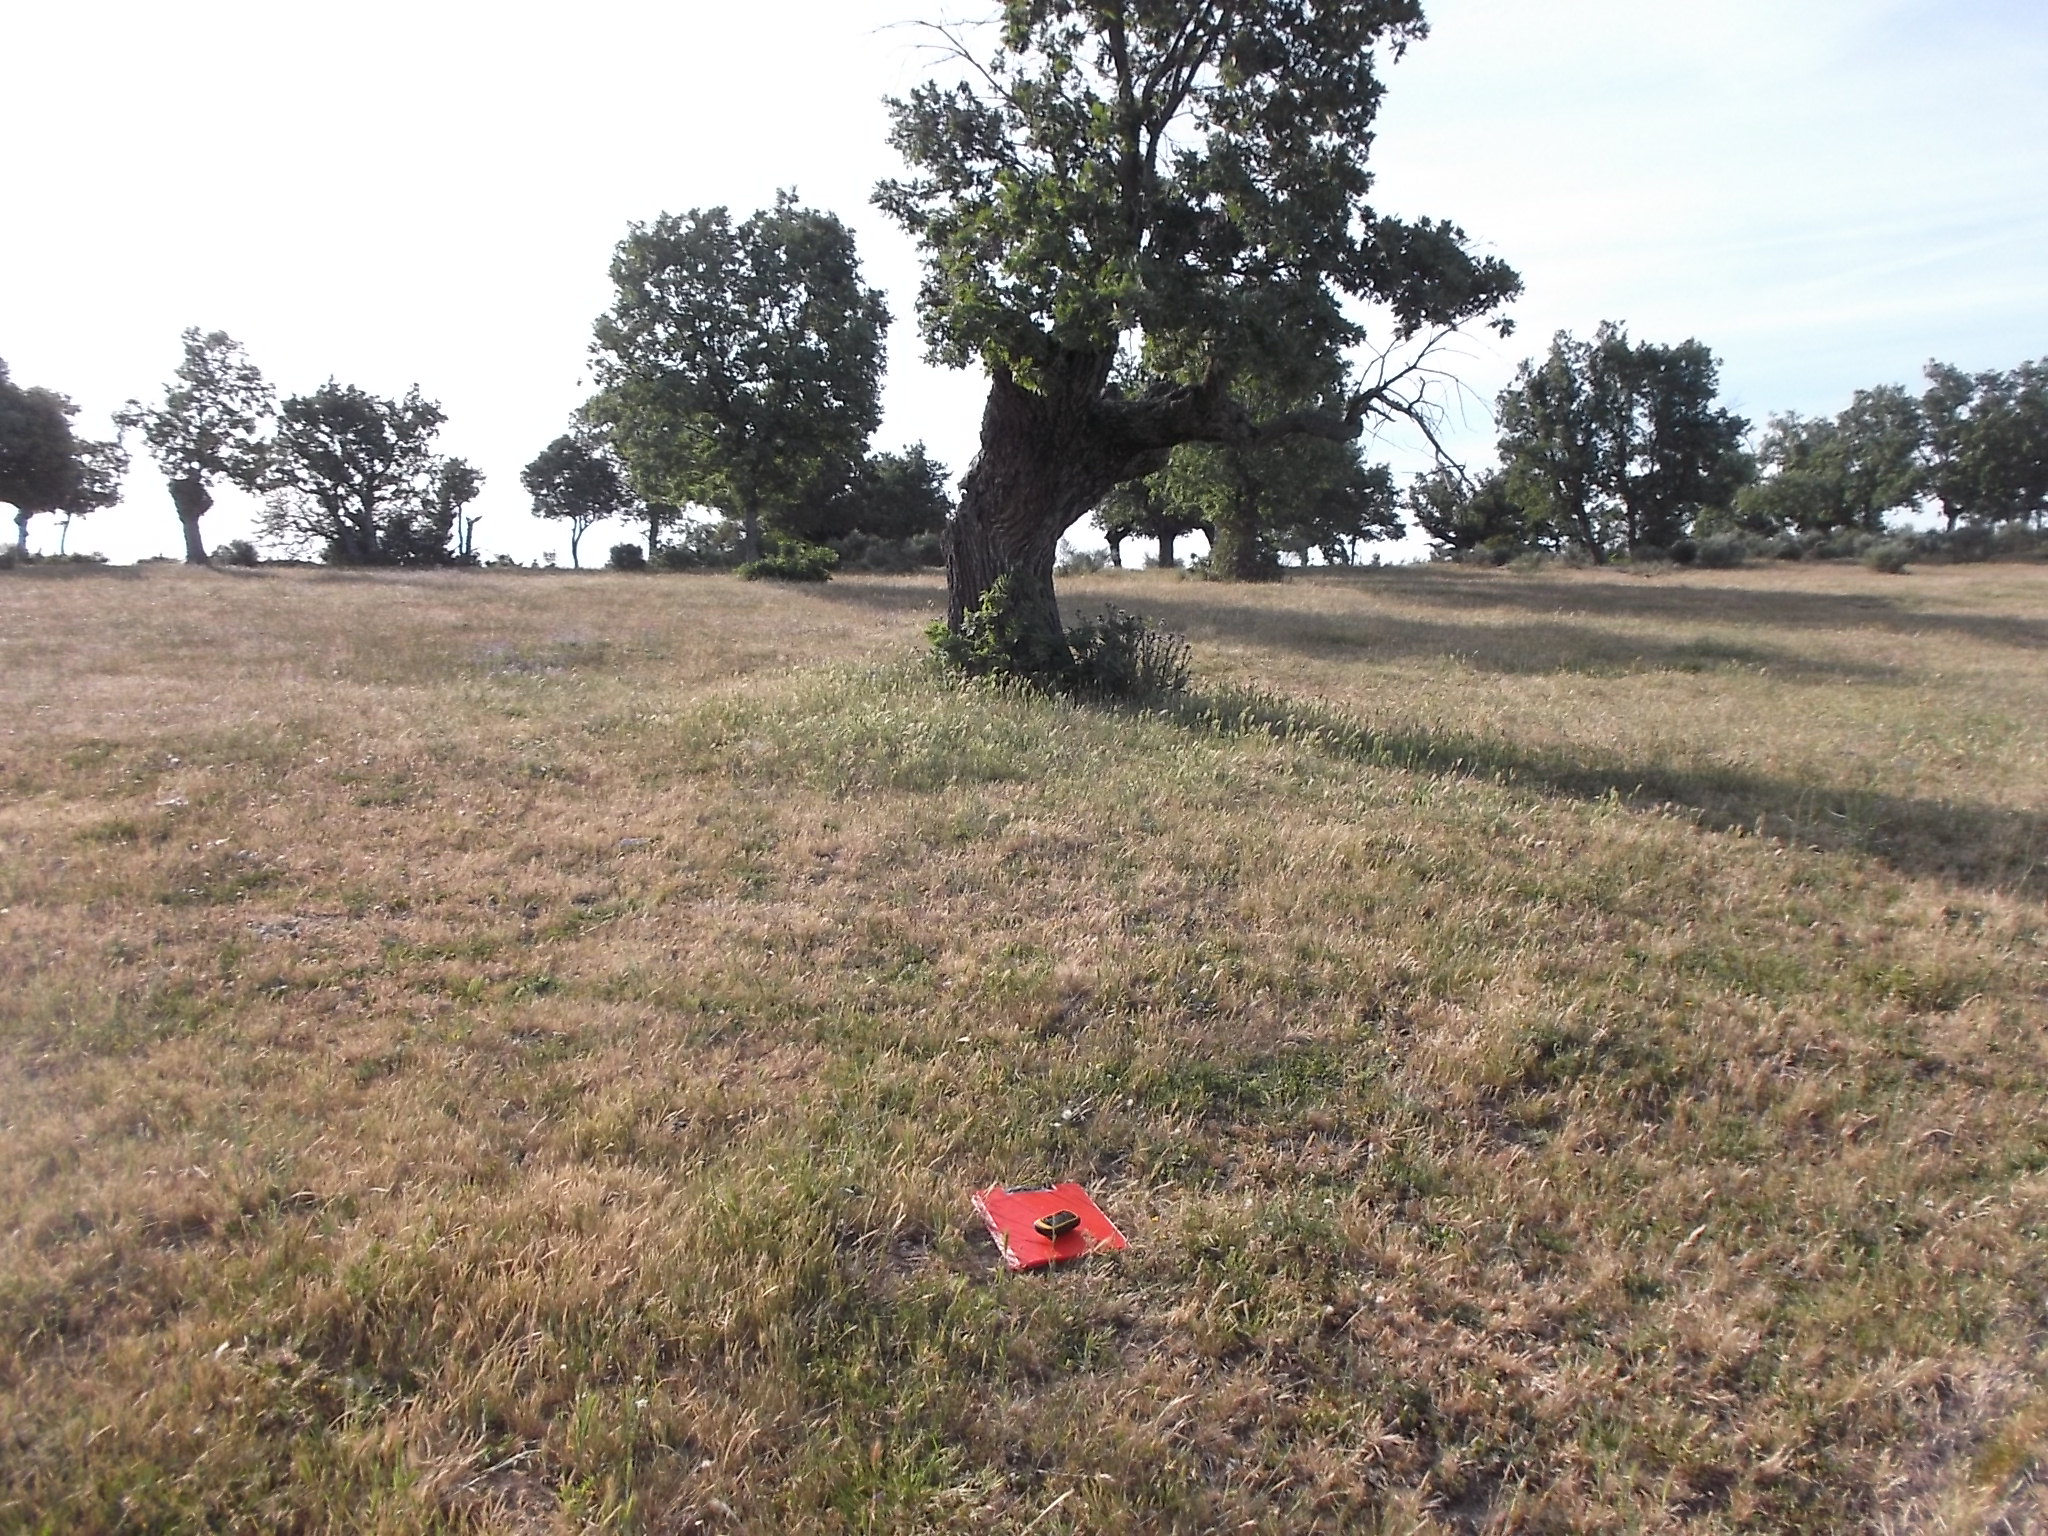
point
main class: Grassland
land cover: Grassland with sparse tree/shrub cover
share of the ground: > 75 %
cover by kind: herbaceous plants 90 %, broadleaved forest trees 5 %, shrubs 5 %
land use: Agriculture (excluding fallow land and kitchen gardens)
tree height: < 5 m
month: May
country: ES
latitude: 41.0482
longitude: -6.4049
